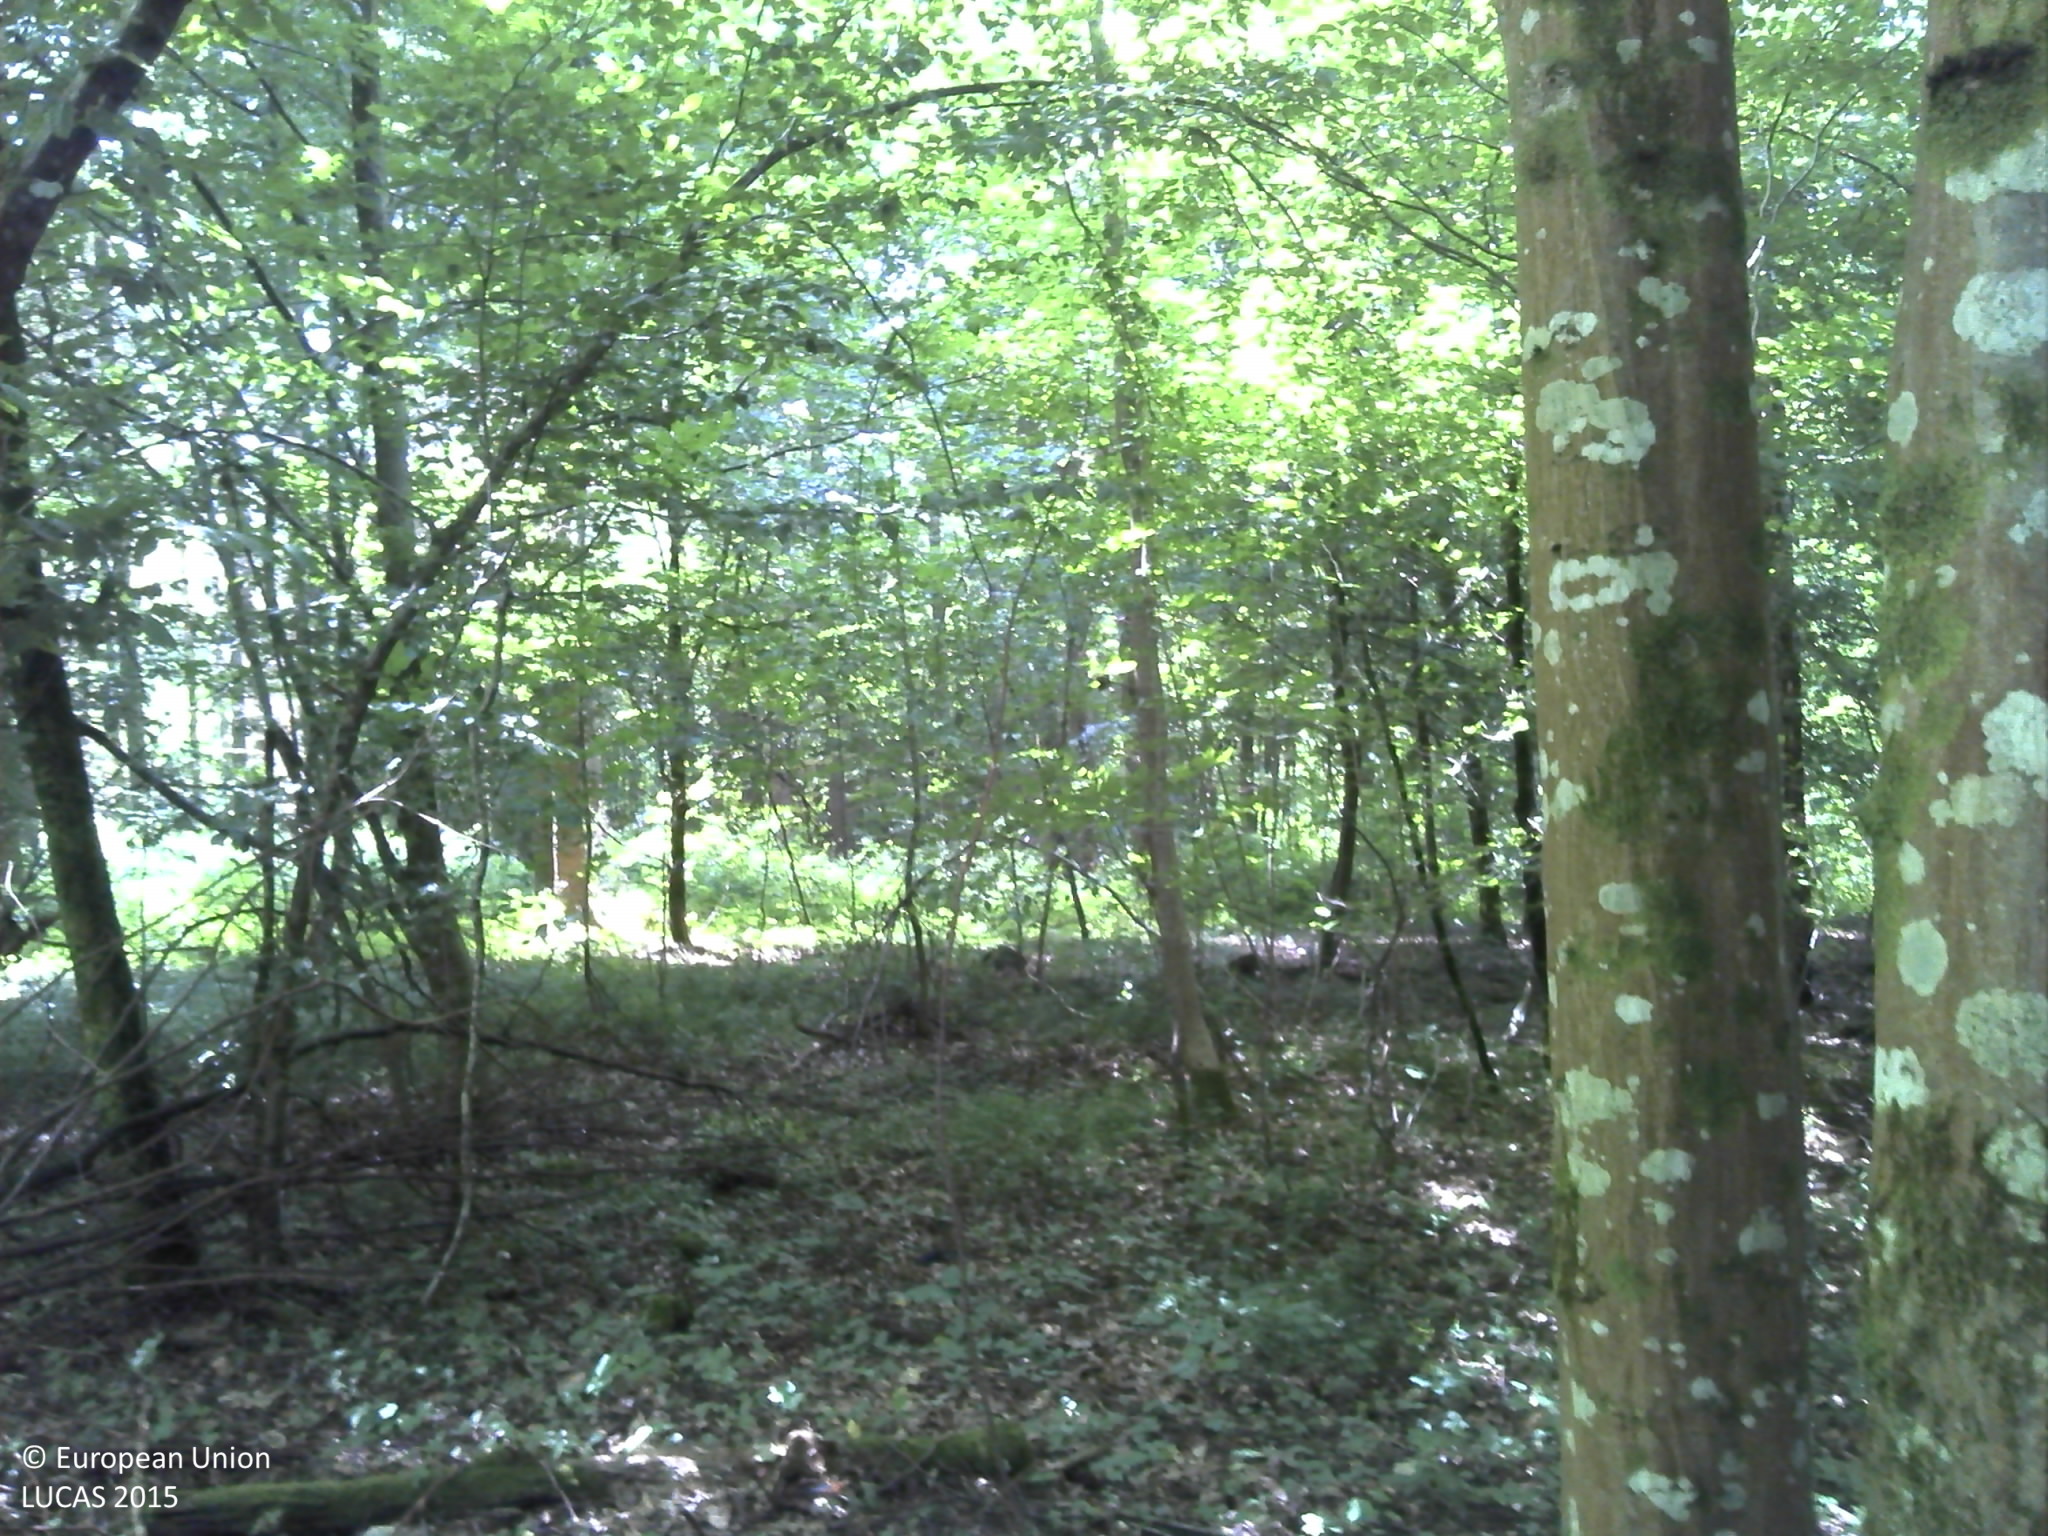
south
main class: Woodland
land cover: Broadleaved woodland
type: beech forest
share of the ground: 50 - 75 %
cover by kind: broadleaved forest trees 75 %, herbaceous plants 15 %, consolidated bare surface 10 %
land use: Forestry
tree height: > 5 m
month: June
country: FR
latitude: 49.7321
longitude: 4.2377
